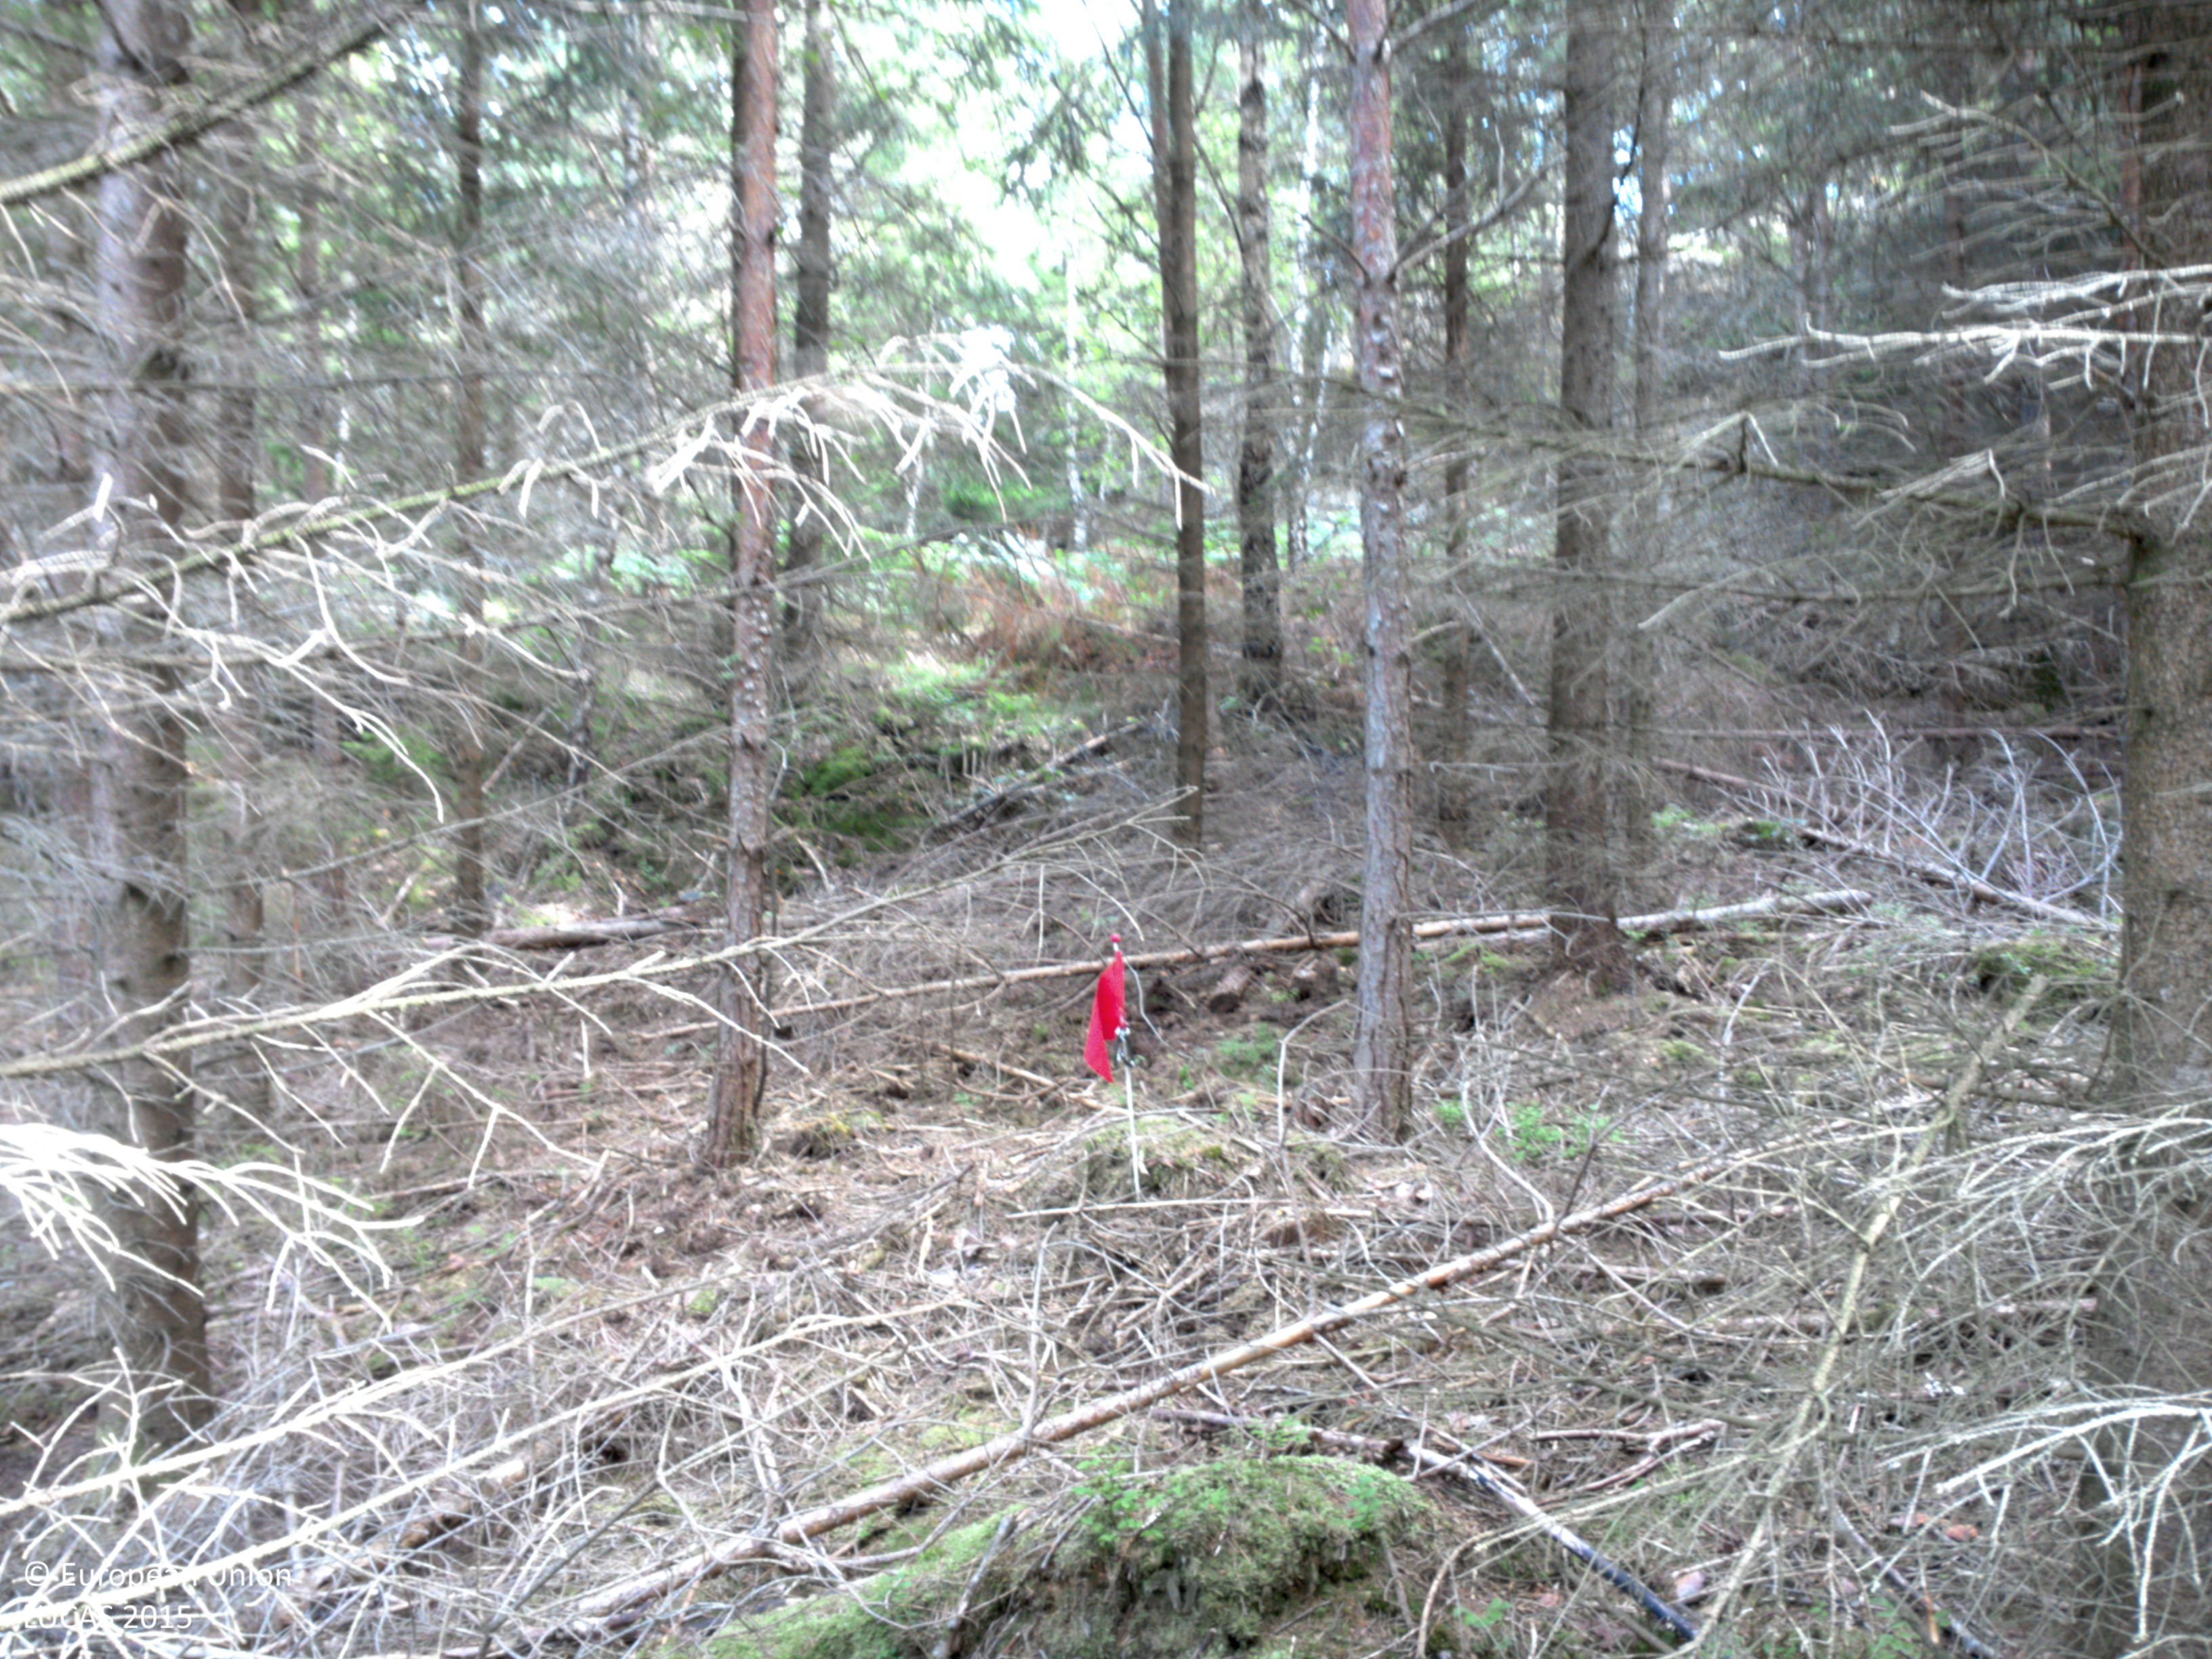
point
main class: Woodland
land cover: Other coniferous woodland
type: boreal forest
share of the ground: > 75 %
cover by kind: coniferous forest trees 90 %, shrubs 5 %, lichens and mosses 5 %
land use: Forestry
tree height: > 5 m
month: August
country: SE
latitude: 58.0076
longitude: 11.9426
